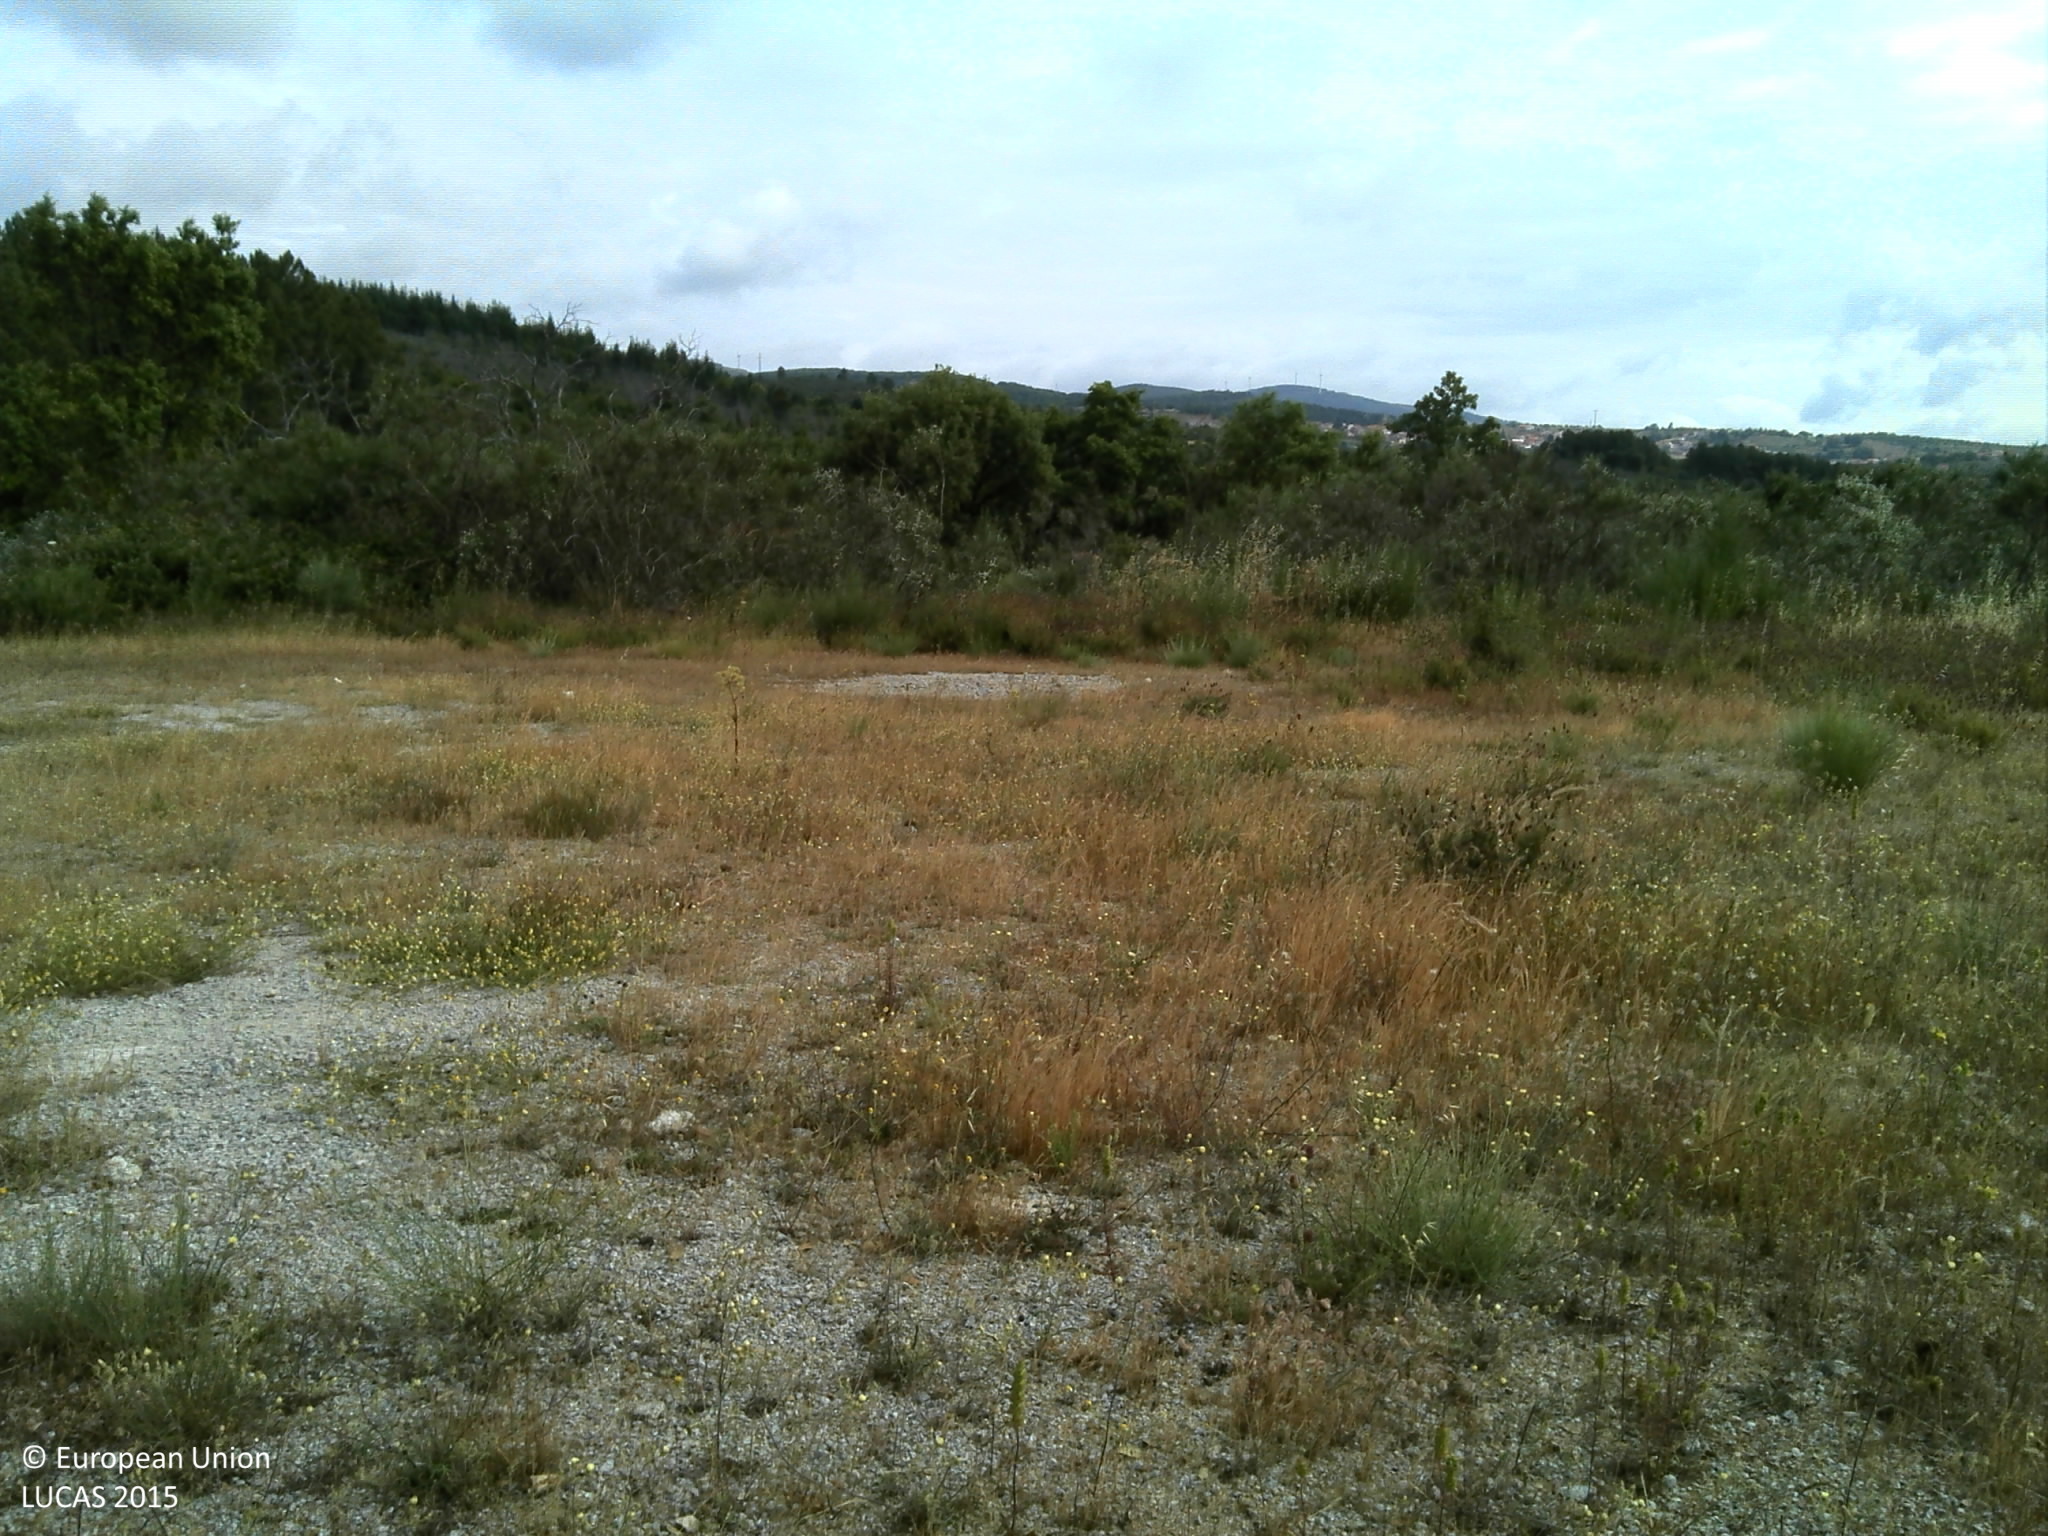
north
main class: Grassland
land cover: Grassland without tree/shrub cover
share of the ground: 10 - 25 %
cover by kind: consolidated bare surface 60 %, unconsolidated bare surface 20 %, herbaceous plants 15 %, shrubs 5 %
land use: Semi-natural and natural areas not in use
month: June
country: PT
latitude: 41.3909
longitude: -6.9873
